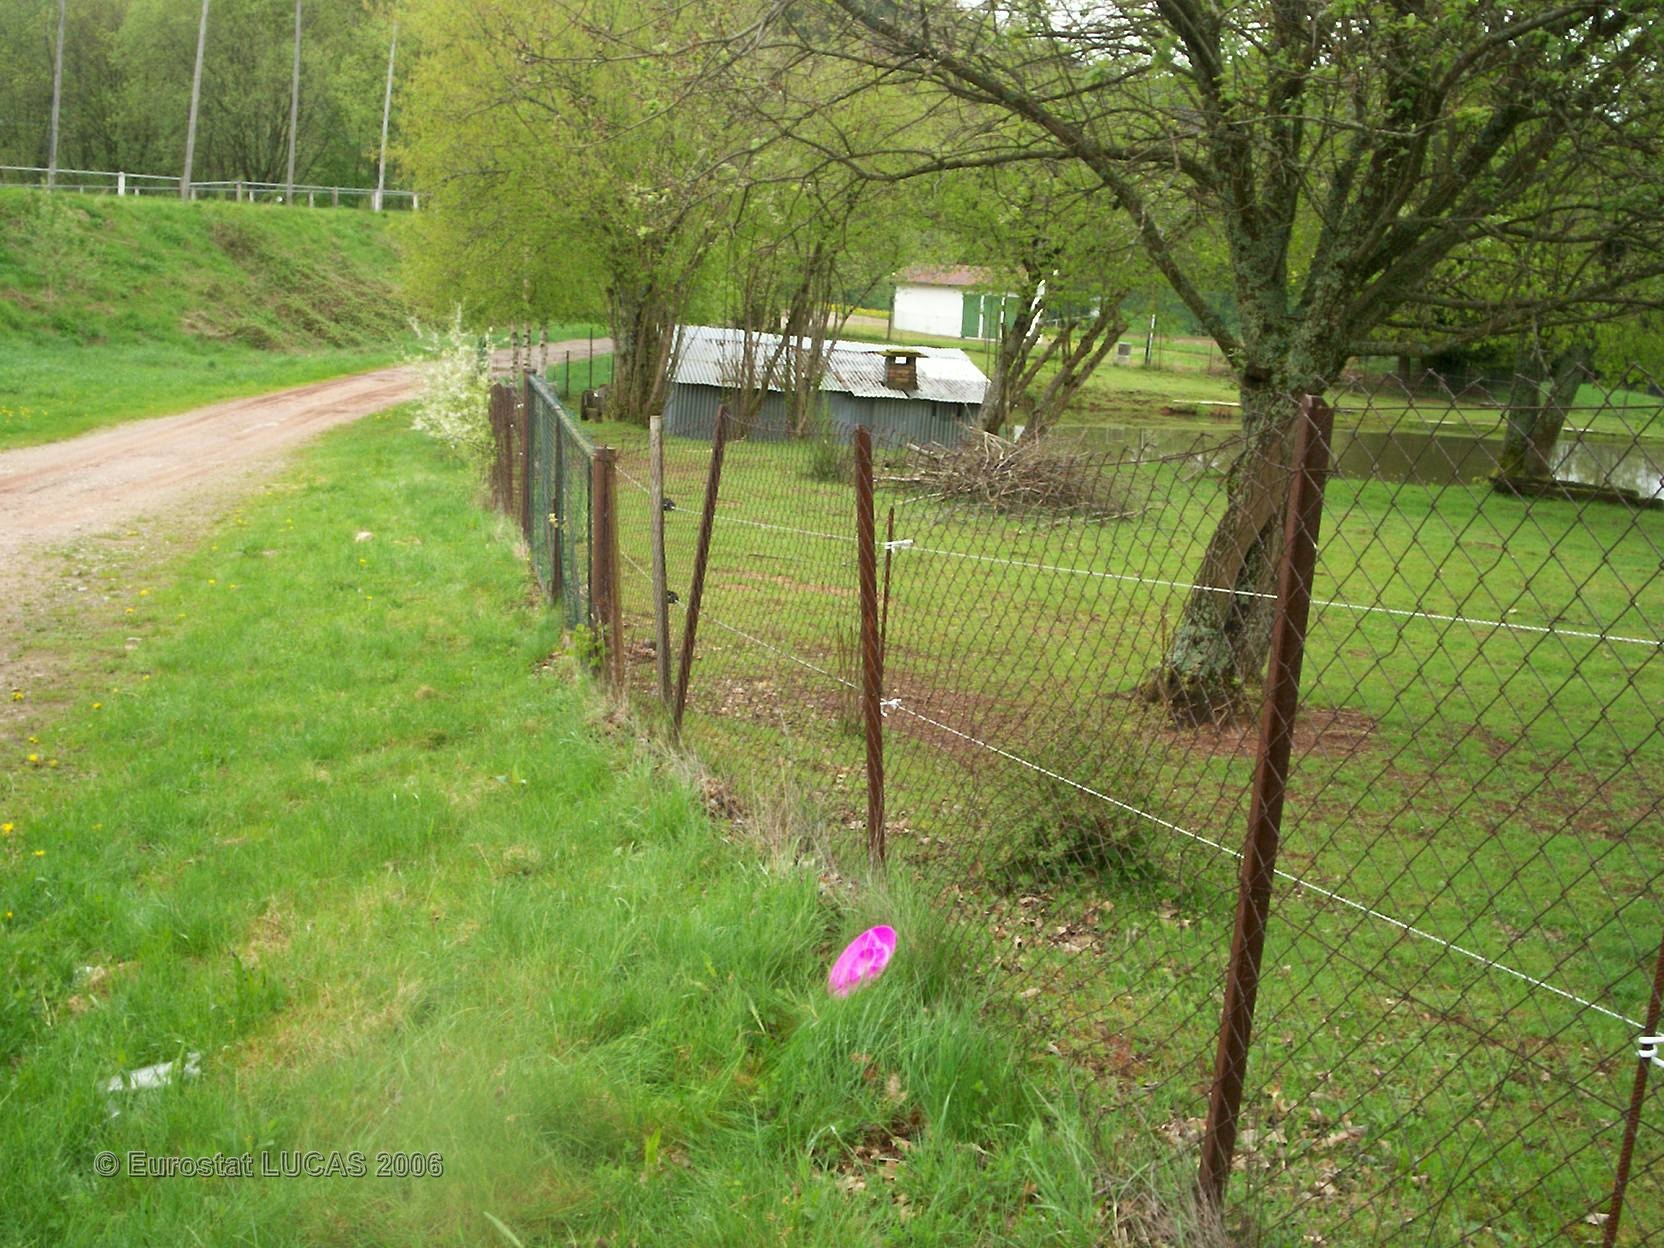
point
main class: Grassland
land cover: Grassland with sparse tree/shrub cover
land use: Amenities, museums, leisure
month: May
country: FR
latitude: 48.3475
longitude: 7.0998
